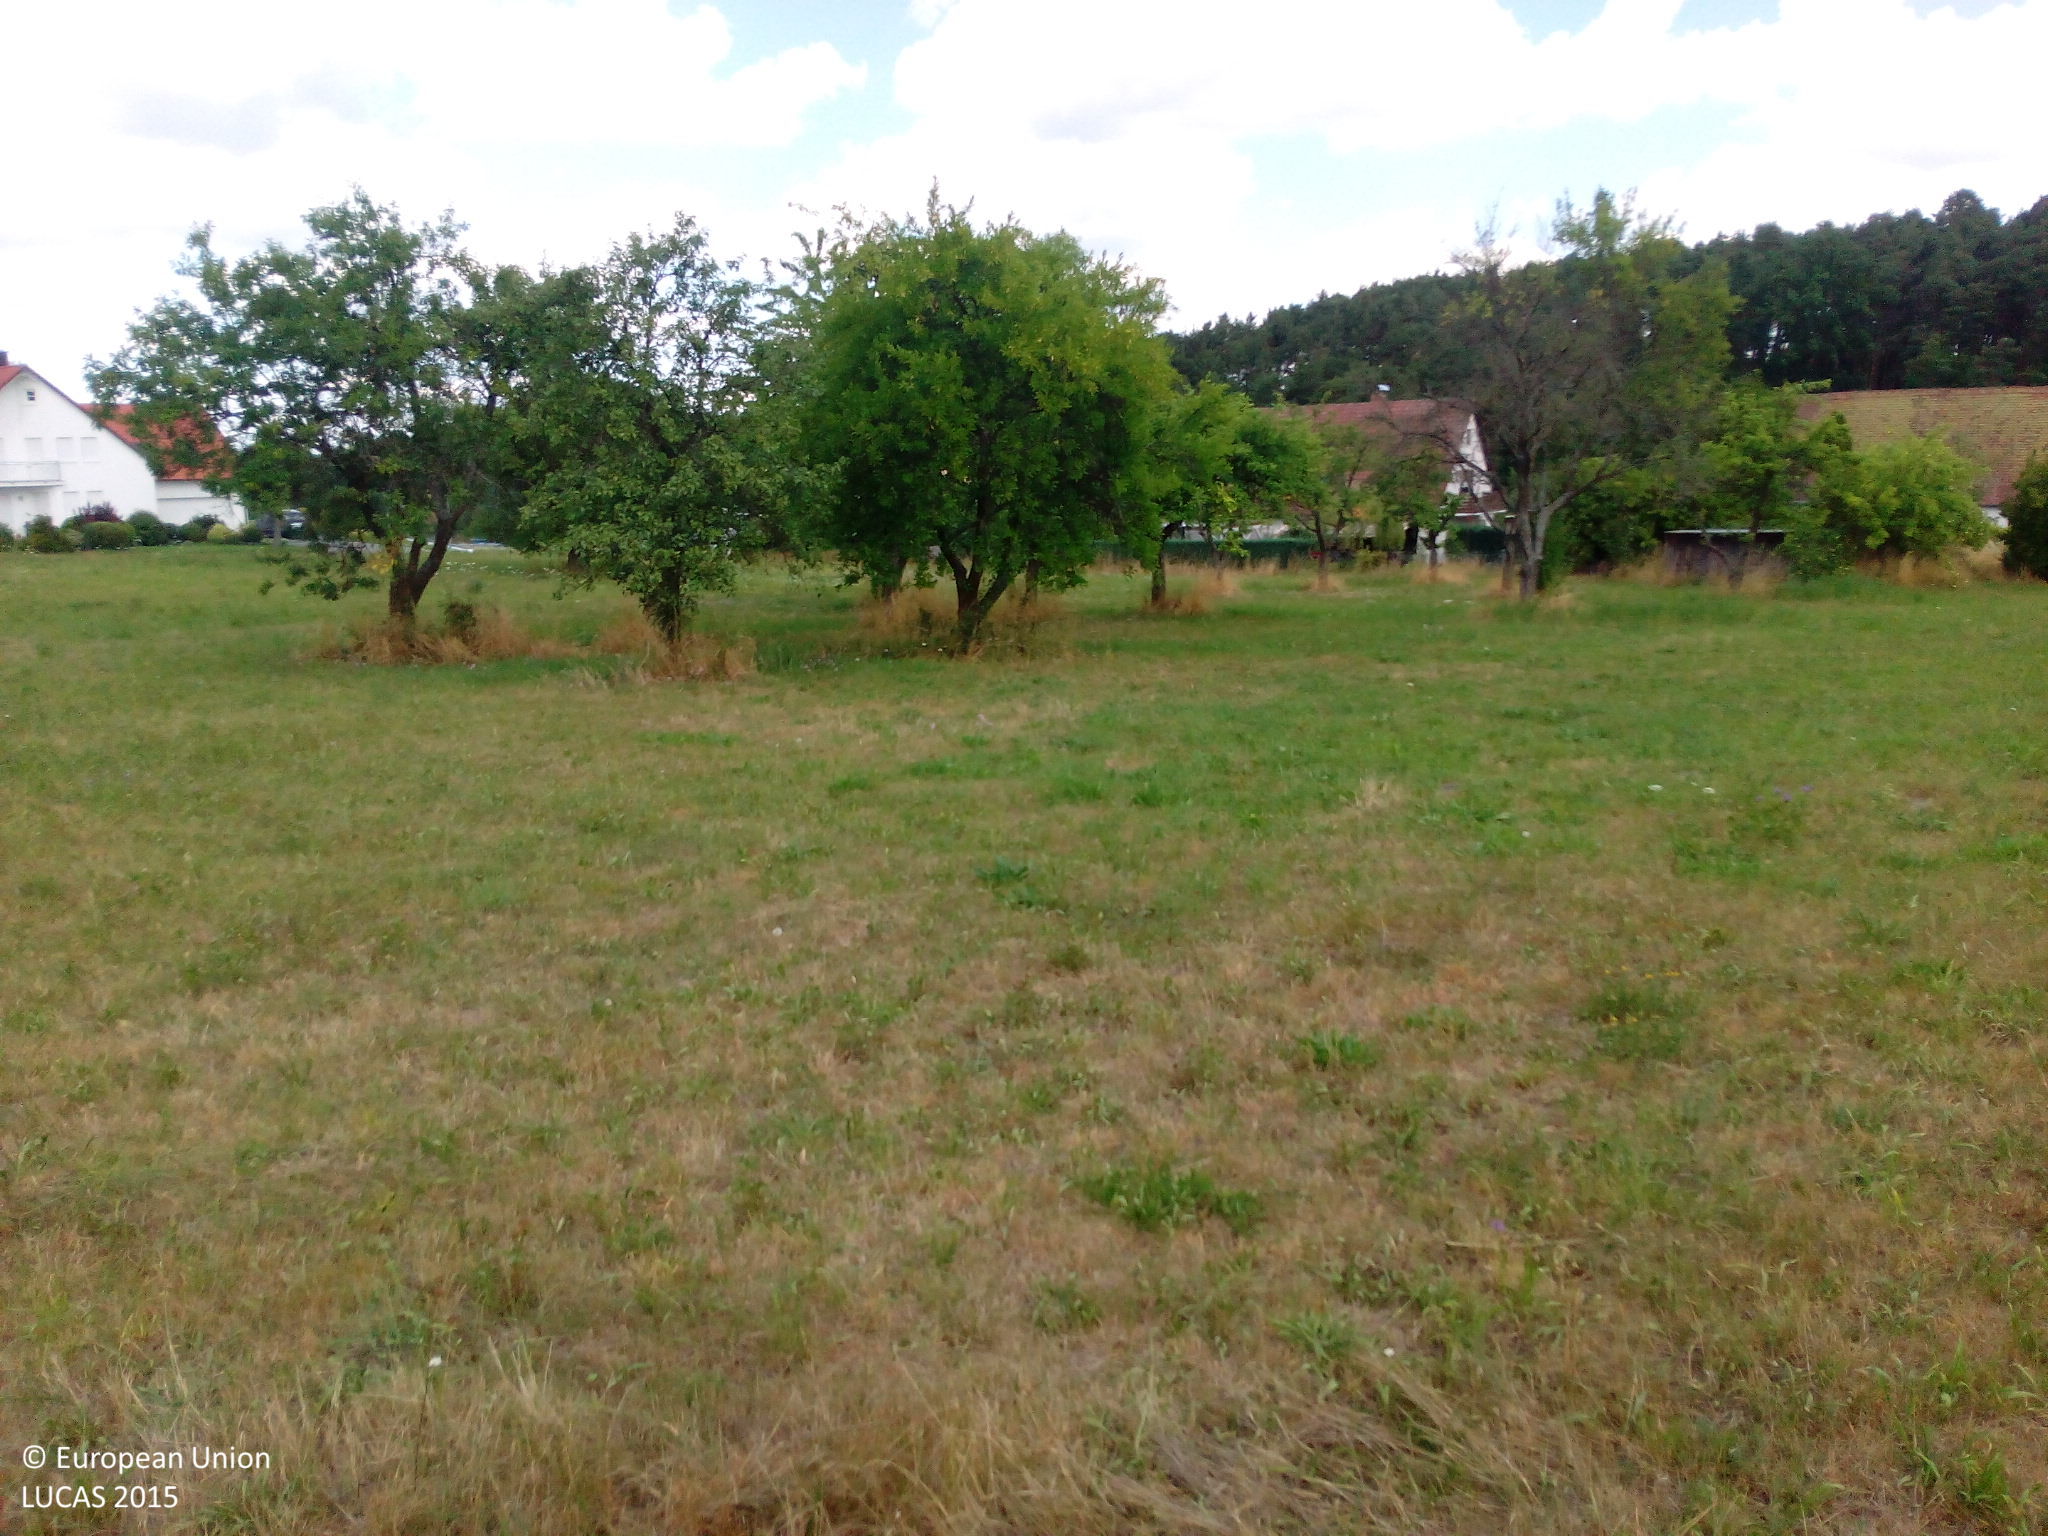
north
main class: Grassland
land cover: Grassland without tree/shrub cover
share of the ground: > 75 %
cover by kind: herbaceous plants 100 %
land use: Agriculture (excluding fallow land and kitchen gardens)
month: July
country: DE
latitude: 49.6949
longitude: 10.9285
